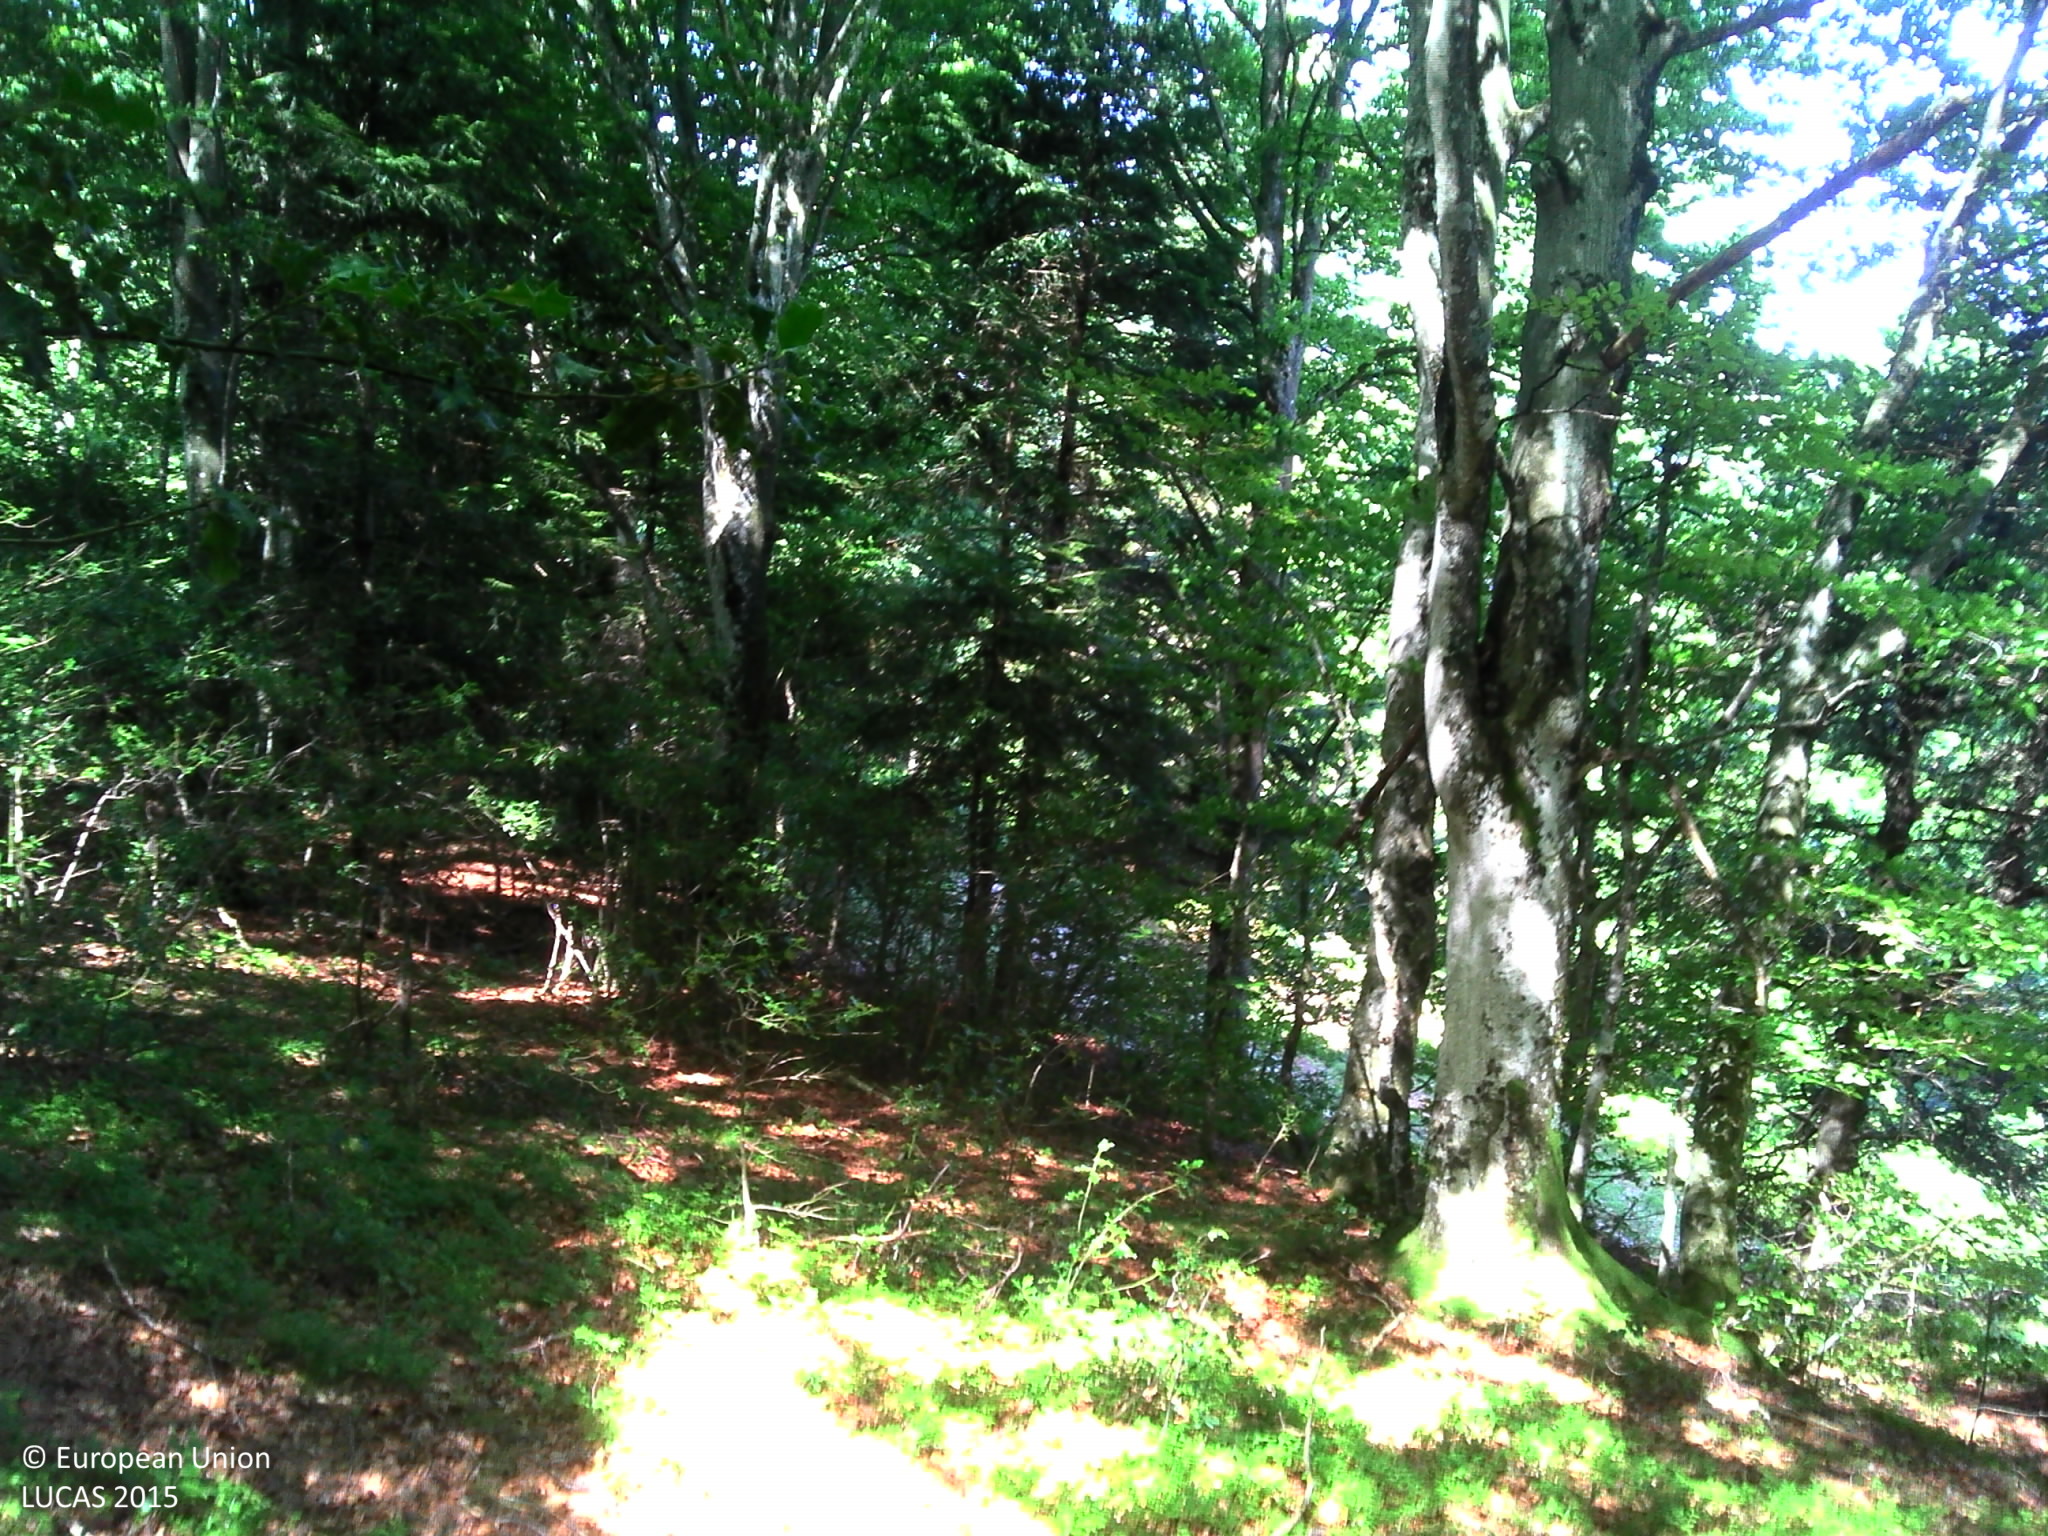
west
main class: Woodland
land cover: Spruce dominated mixed woodland
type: mountainous beech forest
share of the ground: > 75 %
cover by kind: broadleaved forest trees 55 %, coniferous forest trees 20 %, unconsolidated bare surface 15 %, herbaceous plants 10 %
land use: Forestry
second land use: Sport
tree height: > 5 m
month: August
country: FR
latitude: 42.9623
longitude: 1.4370
